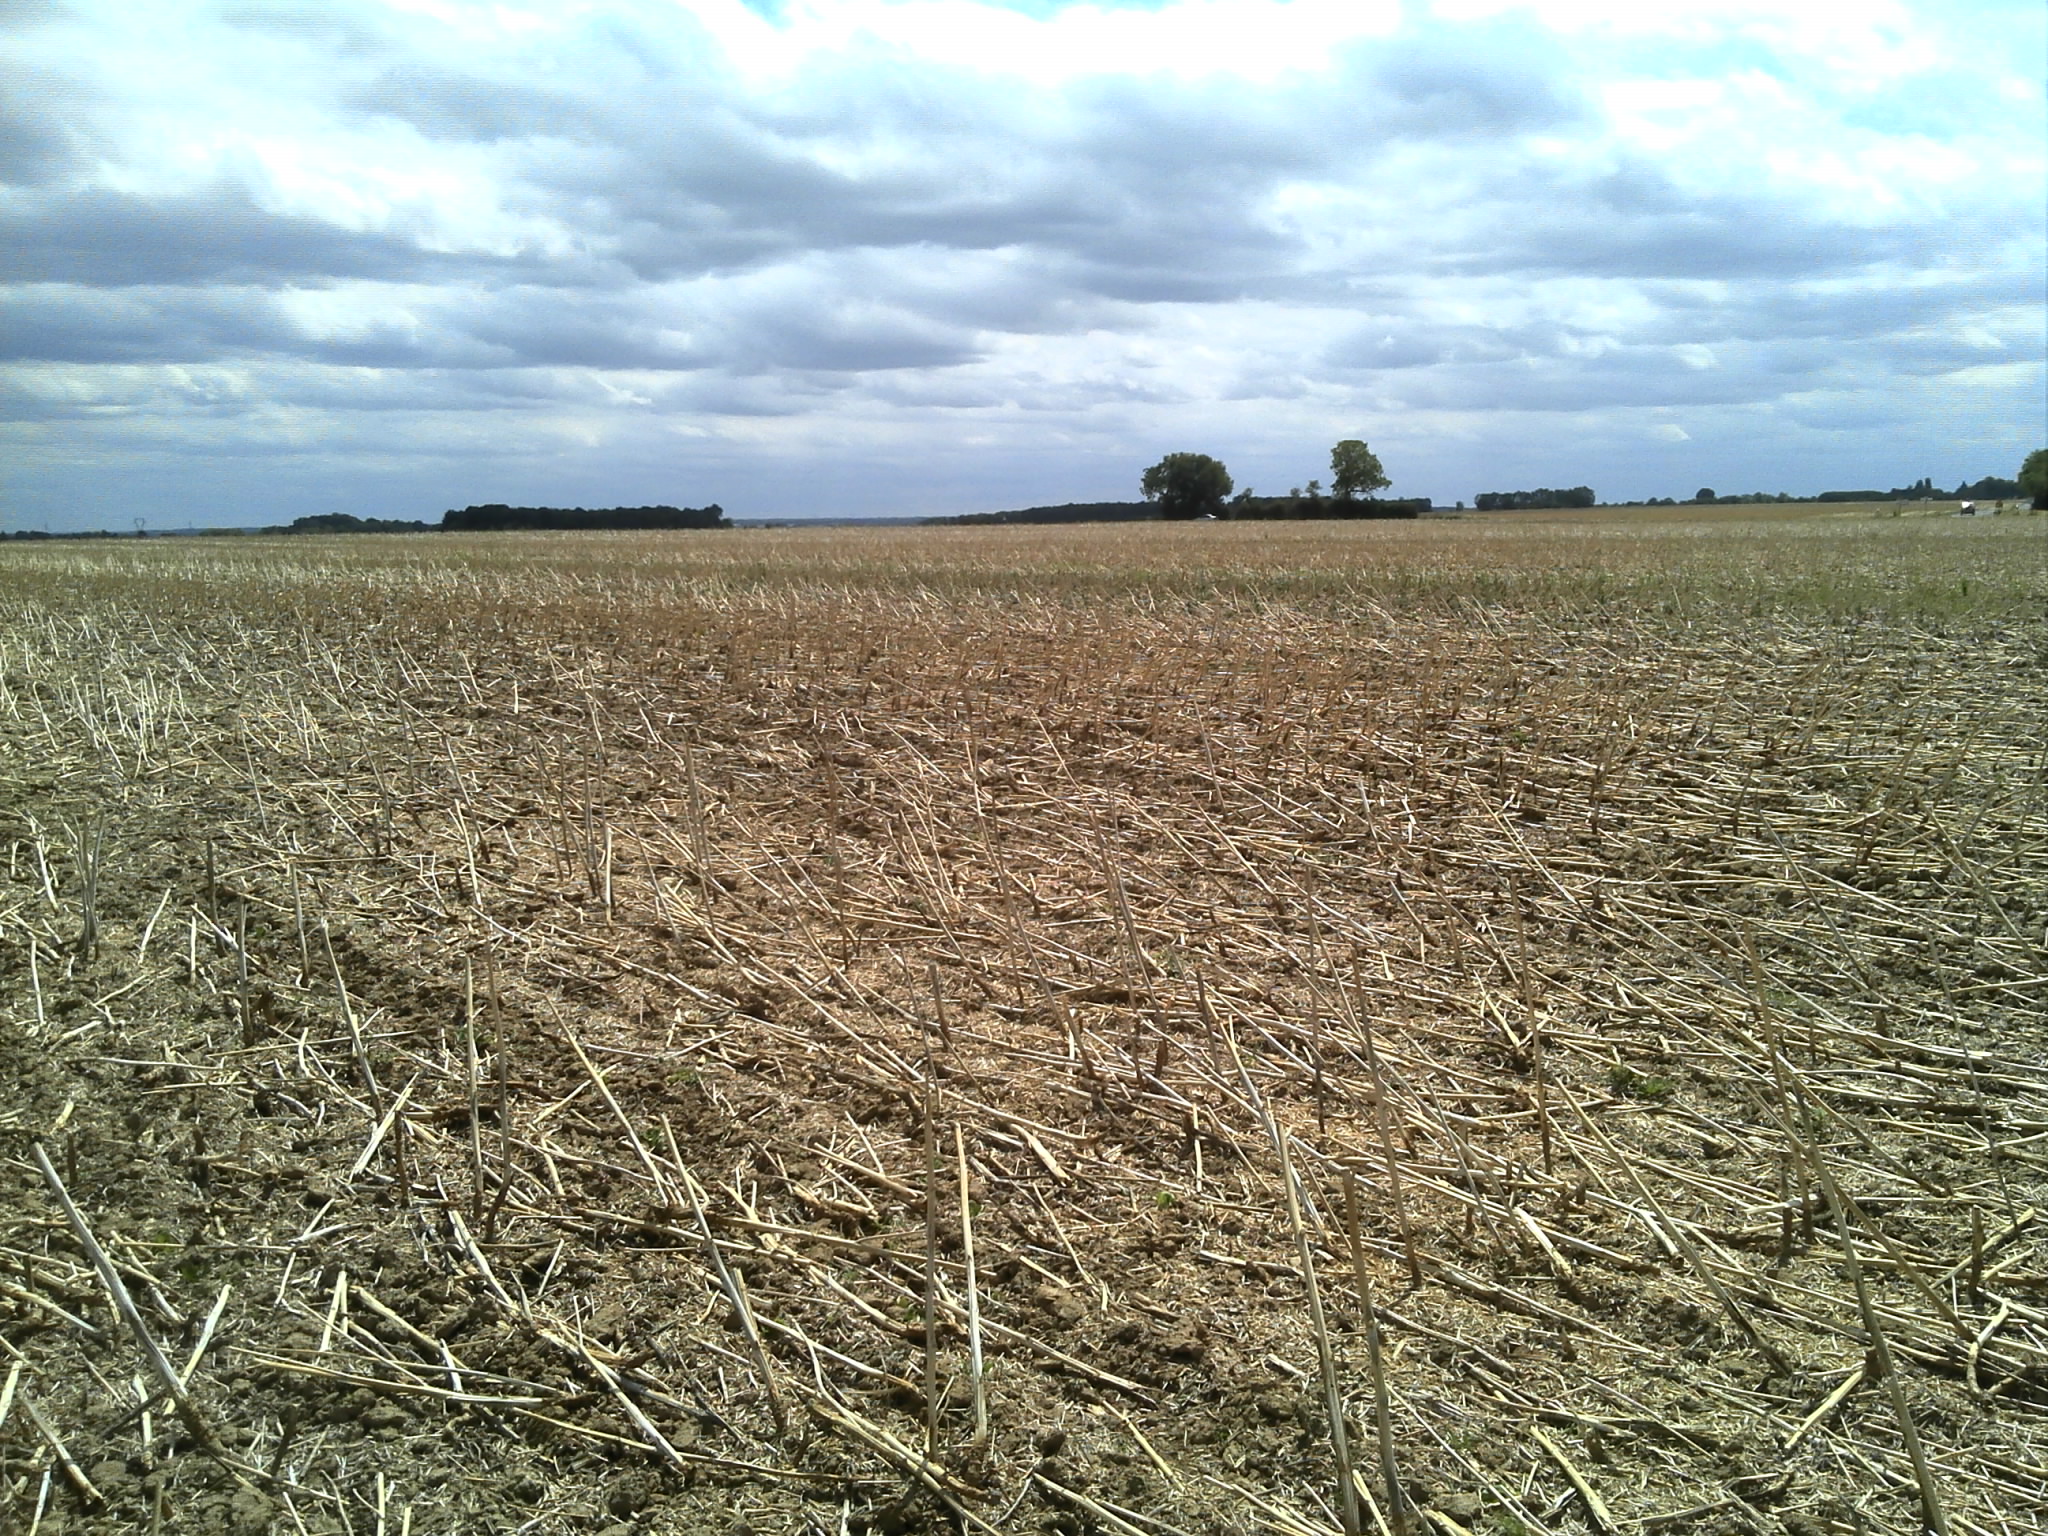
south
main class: Cropland
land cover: Rape and turnip rape
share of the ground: < 10 %
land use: Agriculture (excluding fallow land and kitchen gardens)
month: August
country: FR
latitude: 46.8557
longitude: 1.6344
